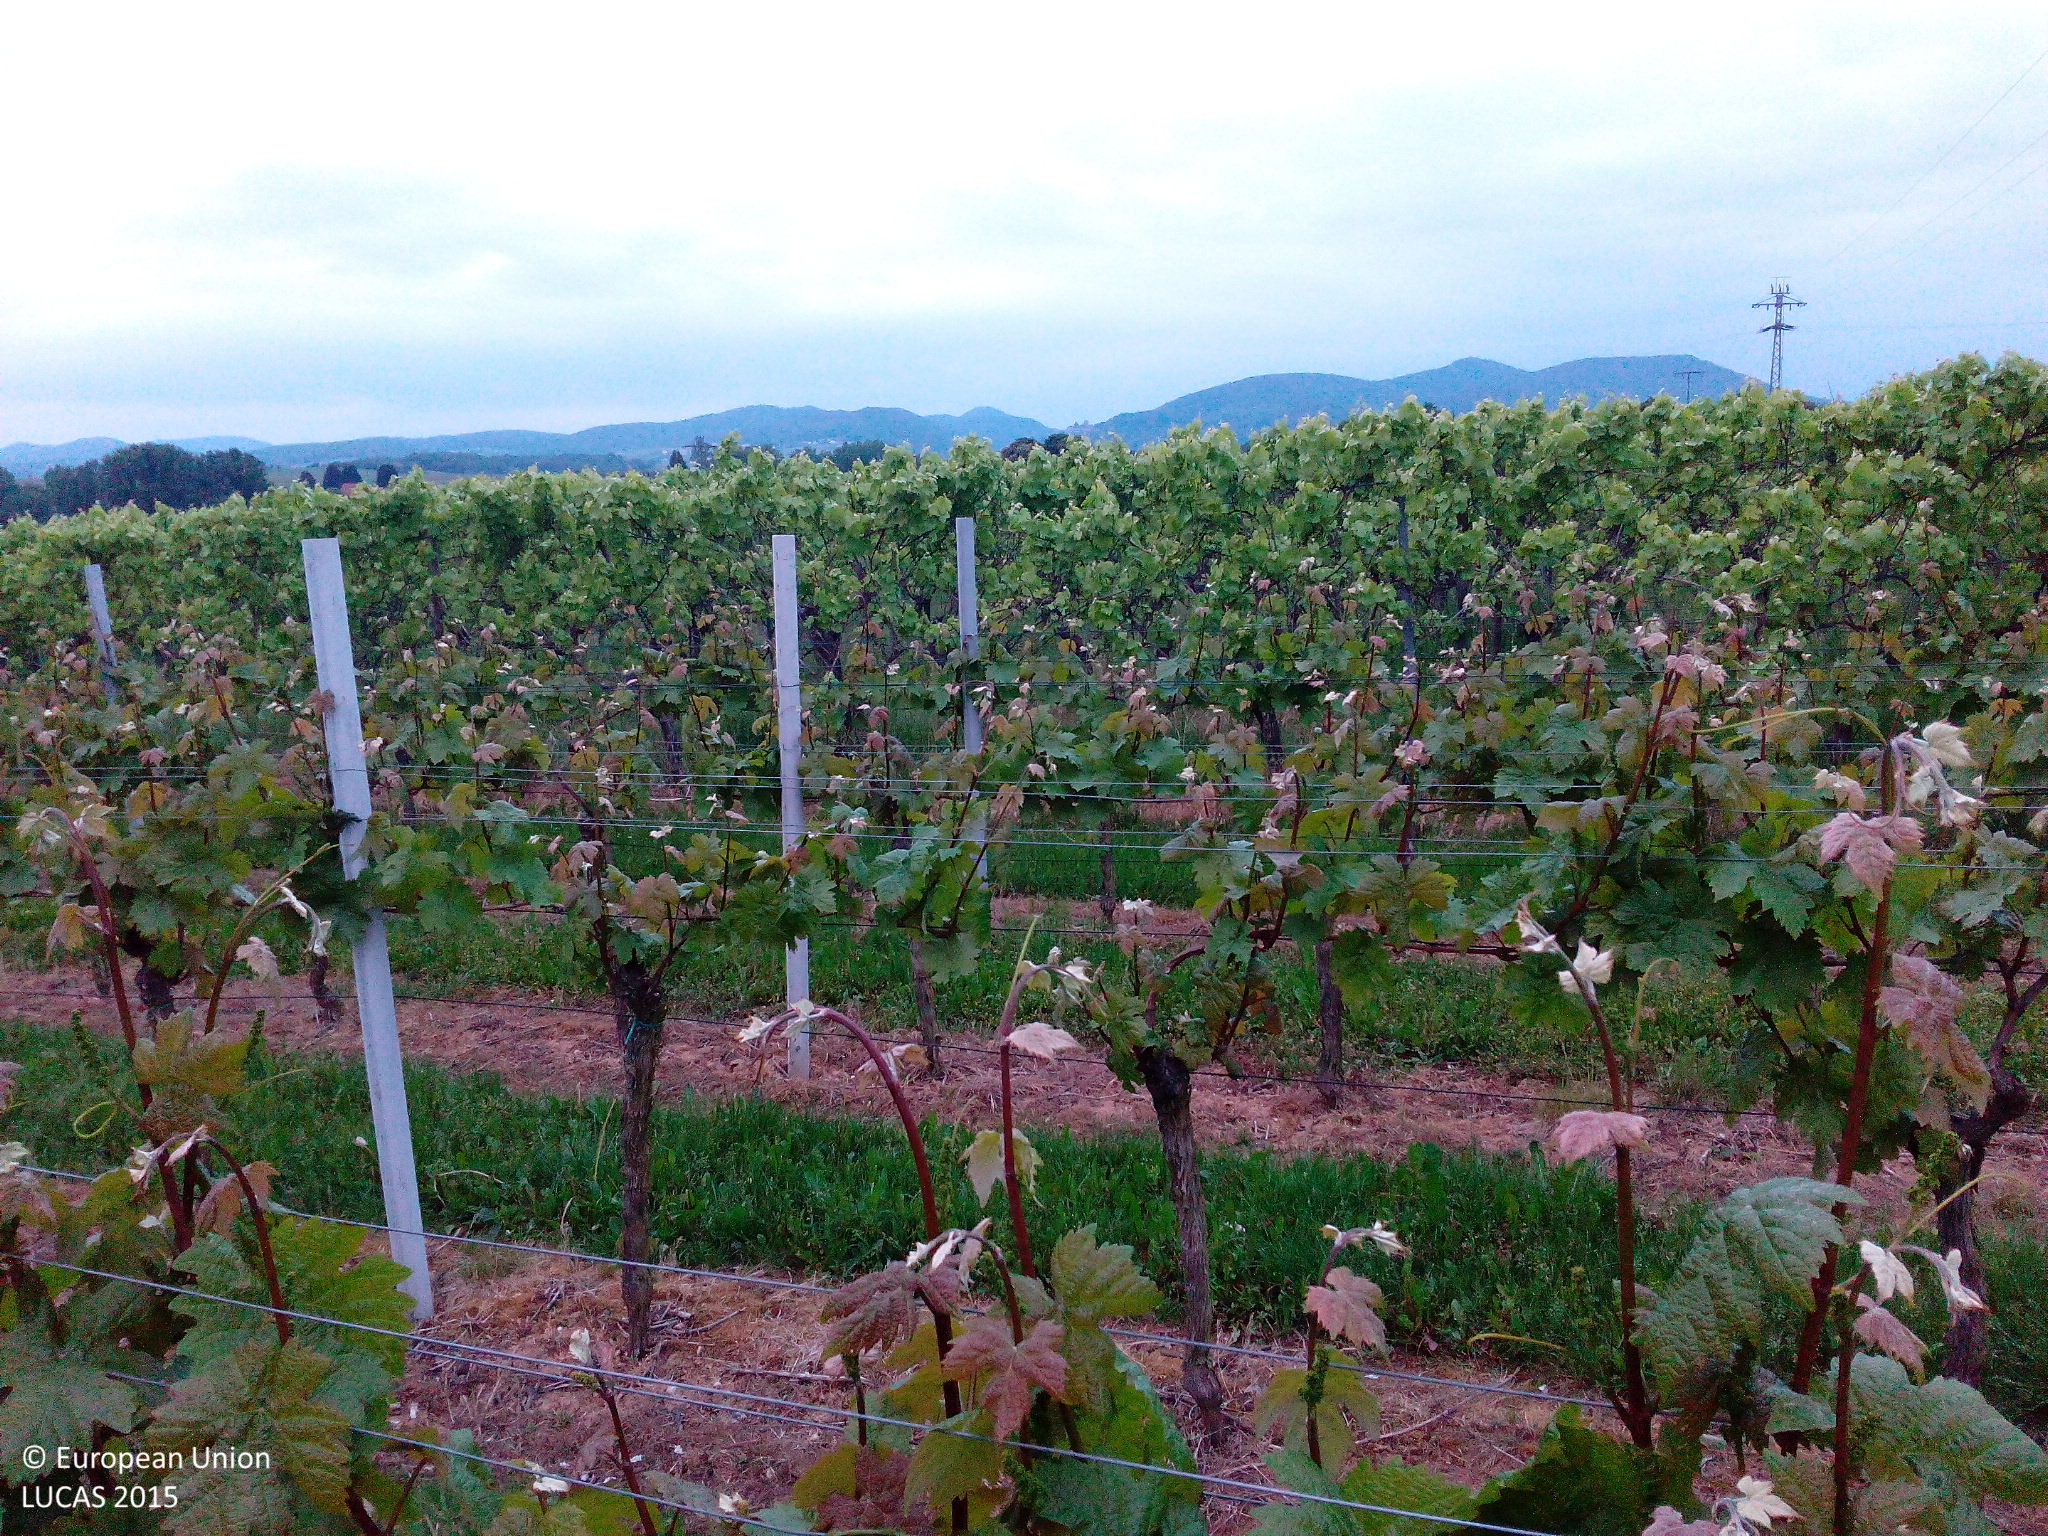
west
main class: Cropland
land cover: Vineyards
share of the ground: 25 - 50 %
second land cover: Grassland without tree/shrub cover
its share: 25 - 50 %
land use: Agriculture (excluding fallow land and kitchen gardens)
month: May
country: DE
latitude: 49.1424
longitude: 8.0678
